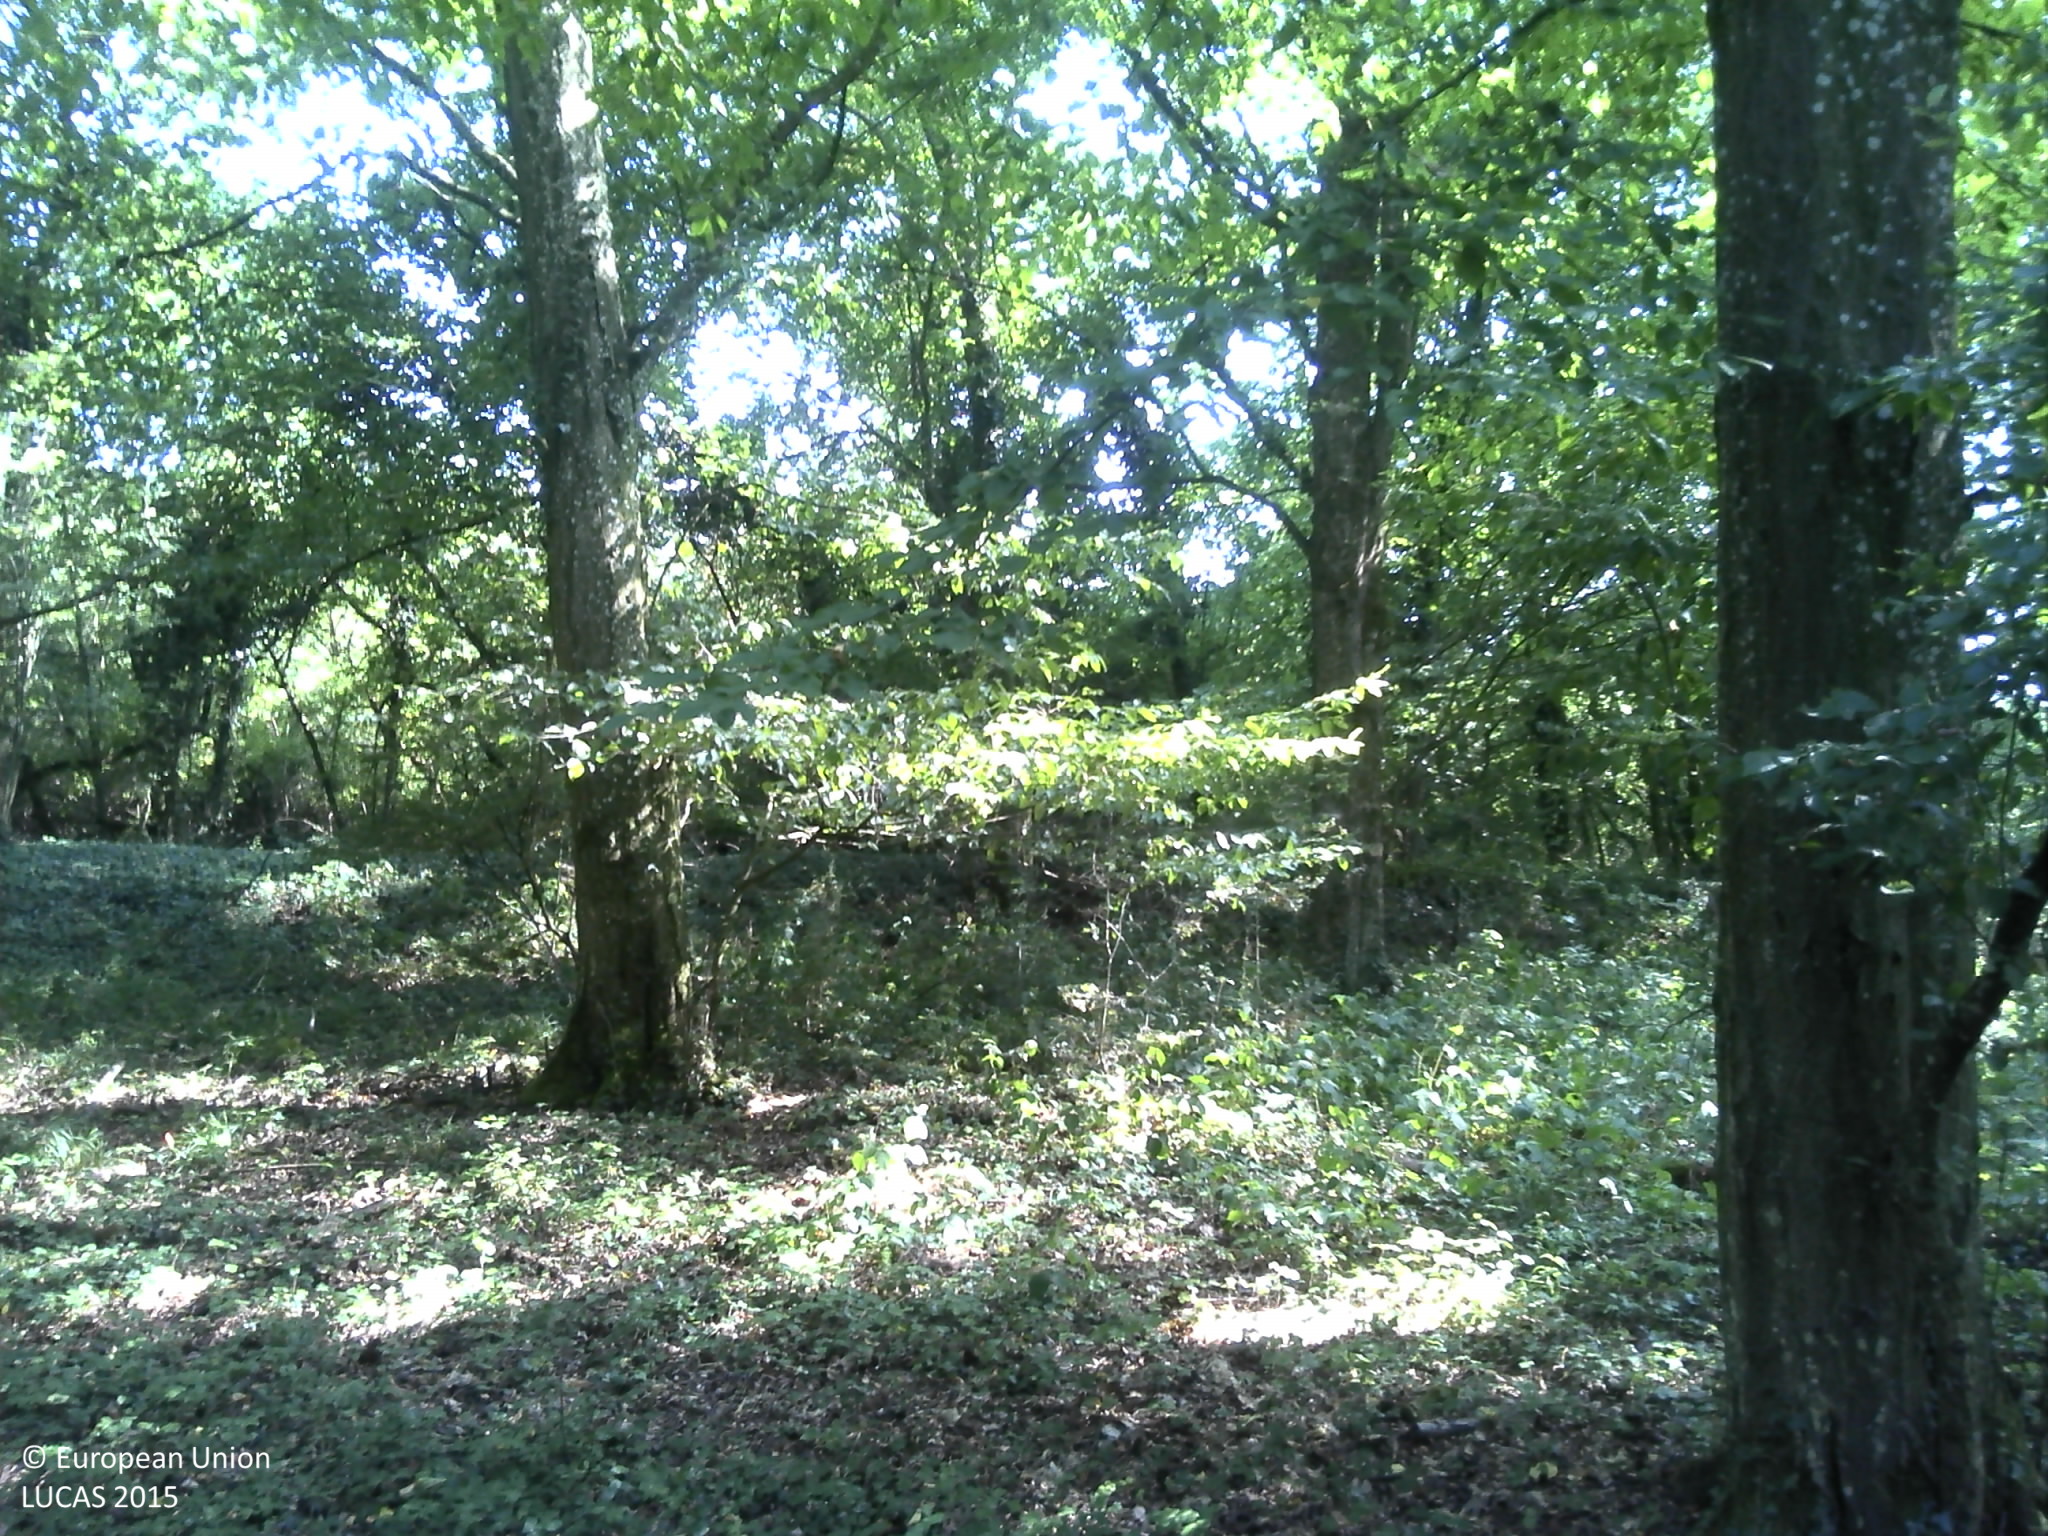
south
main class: Woodland
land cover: Broadleaved woodland
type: acidophilous oak and oak-birch forest
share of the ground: > 75 %
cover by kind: broadleaved forest trees 100 %
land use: Forestry
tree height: > 5 m
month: July
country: FR
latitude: 48.9340
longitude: 6.8197
